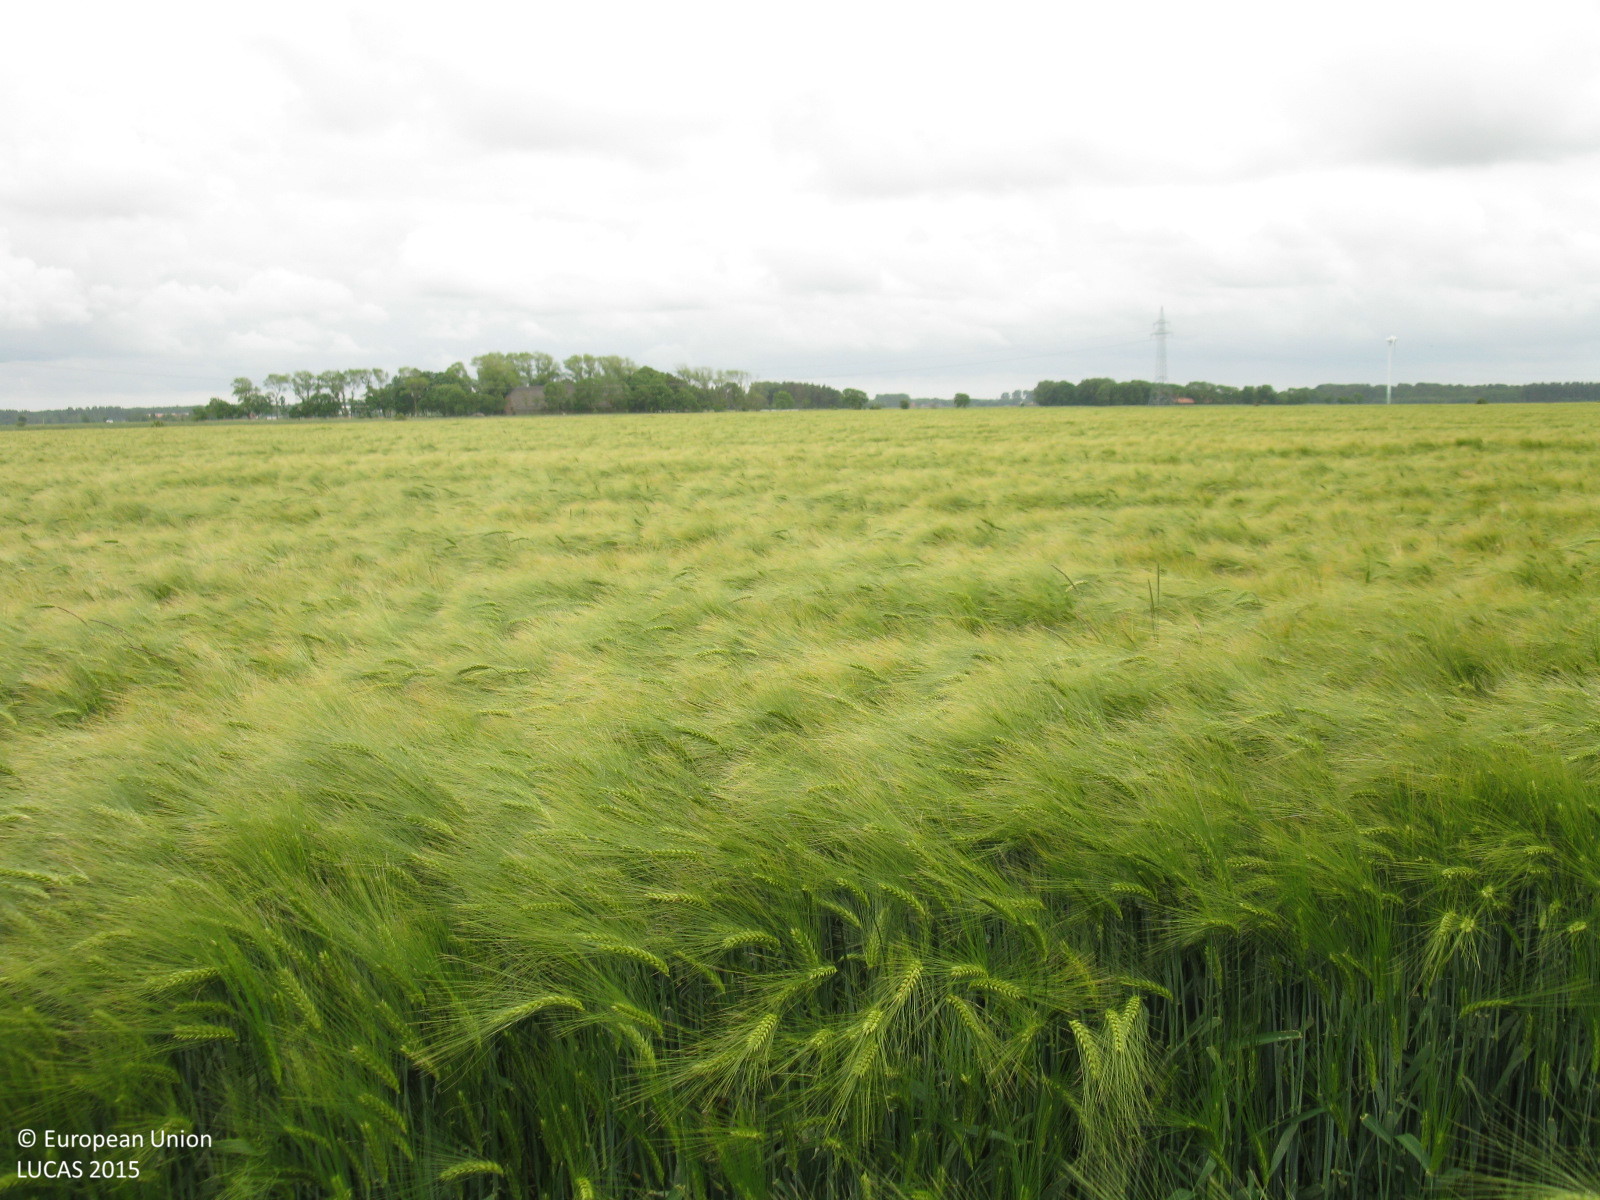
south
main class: Cropland
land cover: Barley
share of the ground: > 75 %
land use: Agriculture (excluding fallow land and kitchen gardens)
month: June
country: DE
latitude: 53.6415
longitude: 7.2932
